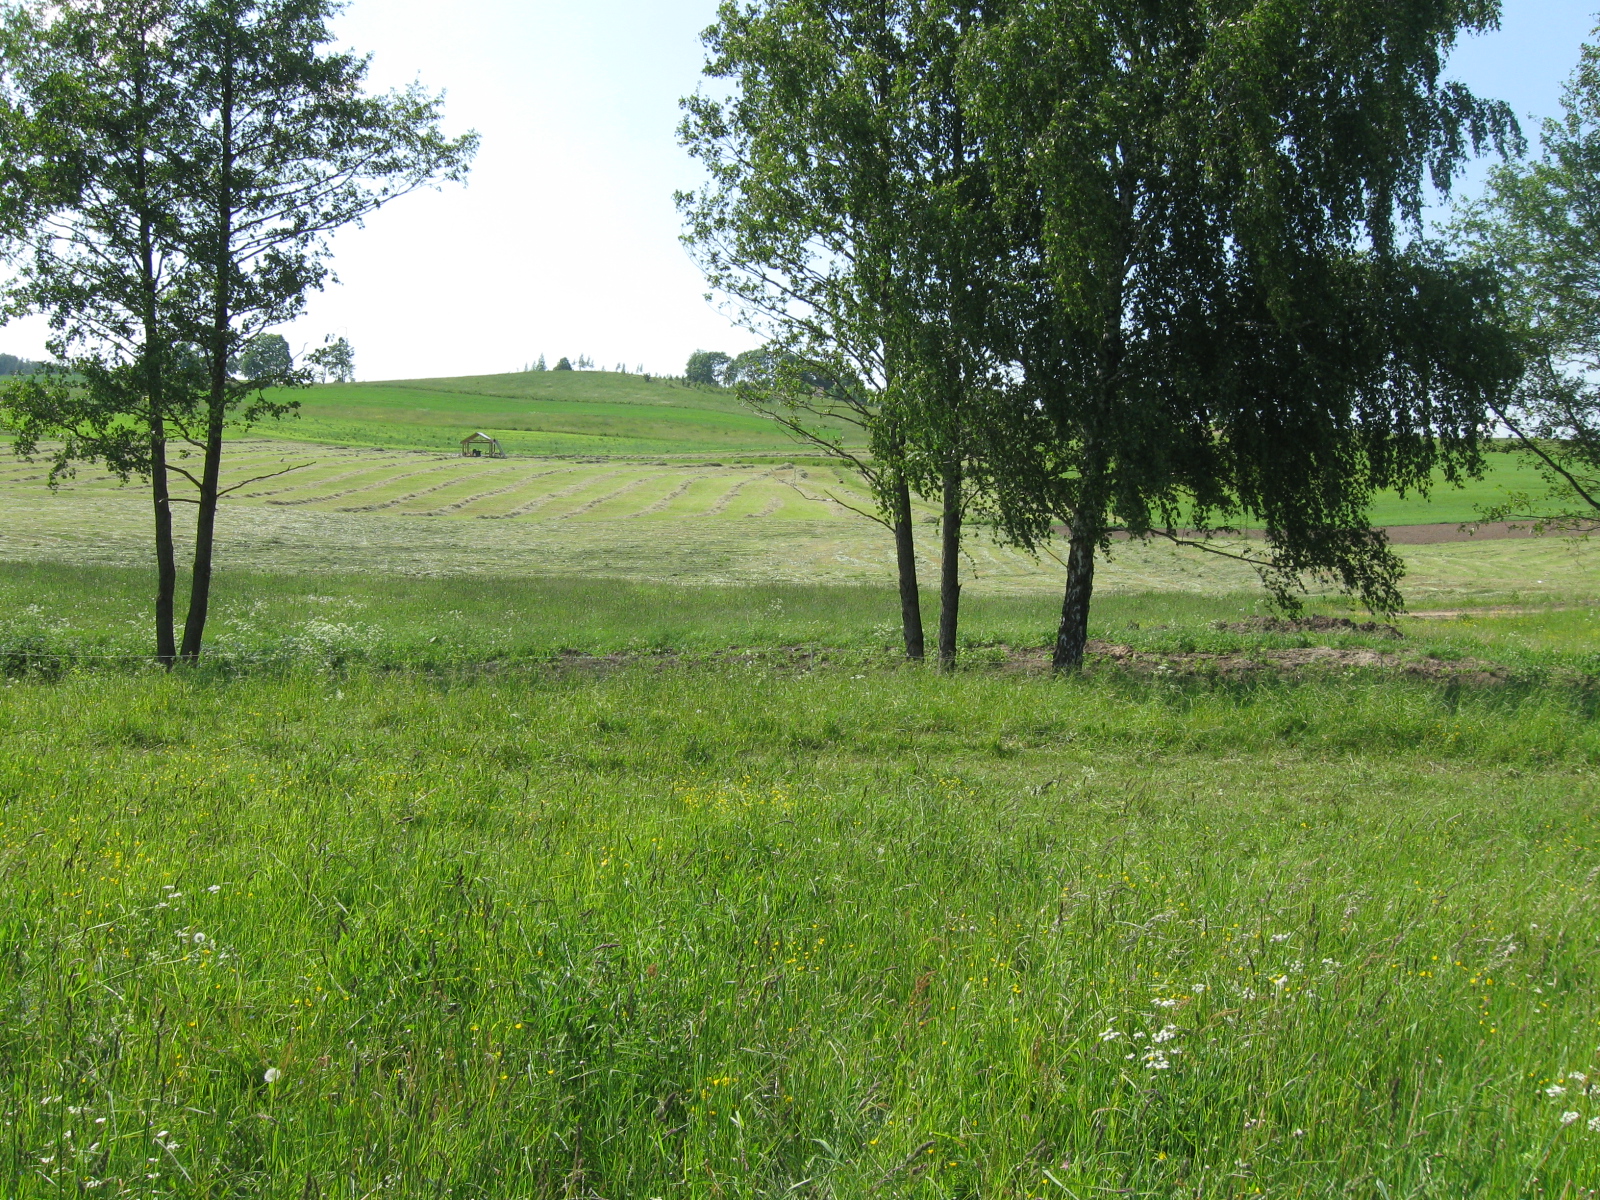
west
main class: Grassland
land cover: Grassland without tree/shrub cover
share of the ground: > 75 %
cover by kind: herbaceous plants 100 %
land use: Agriculture (excluding fallow land and kitchen gardens)
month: June
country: LT
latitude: 54.2540
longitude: 23.7639
